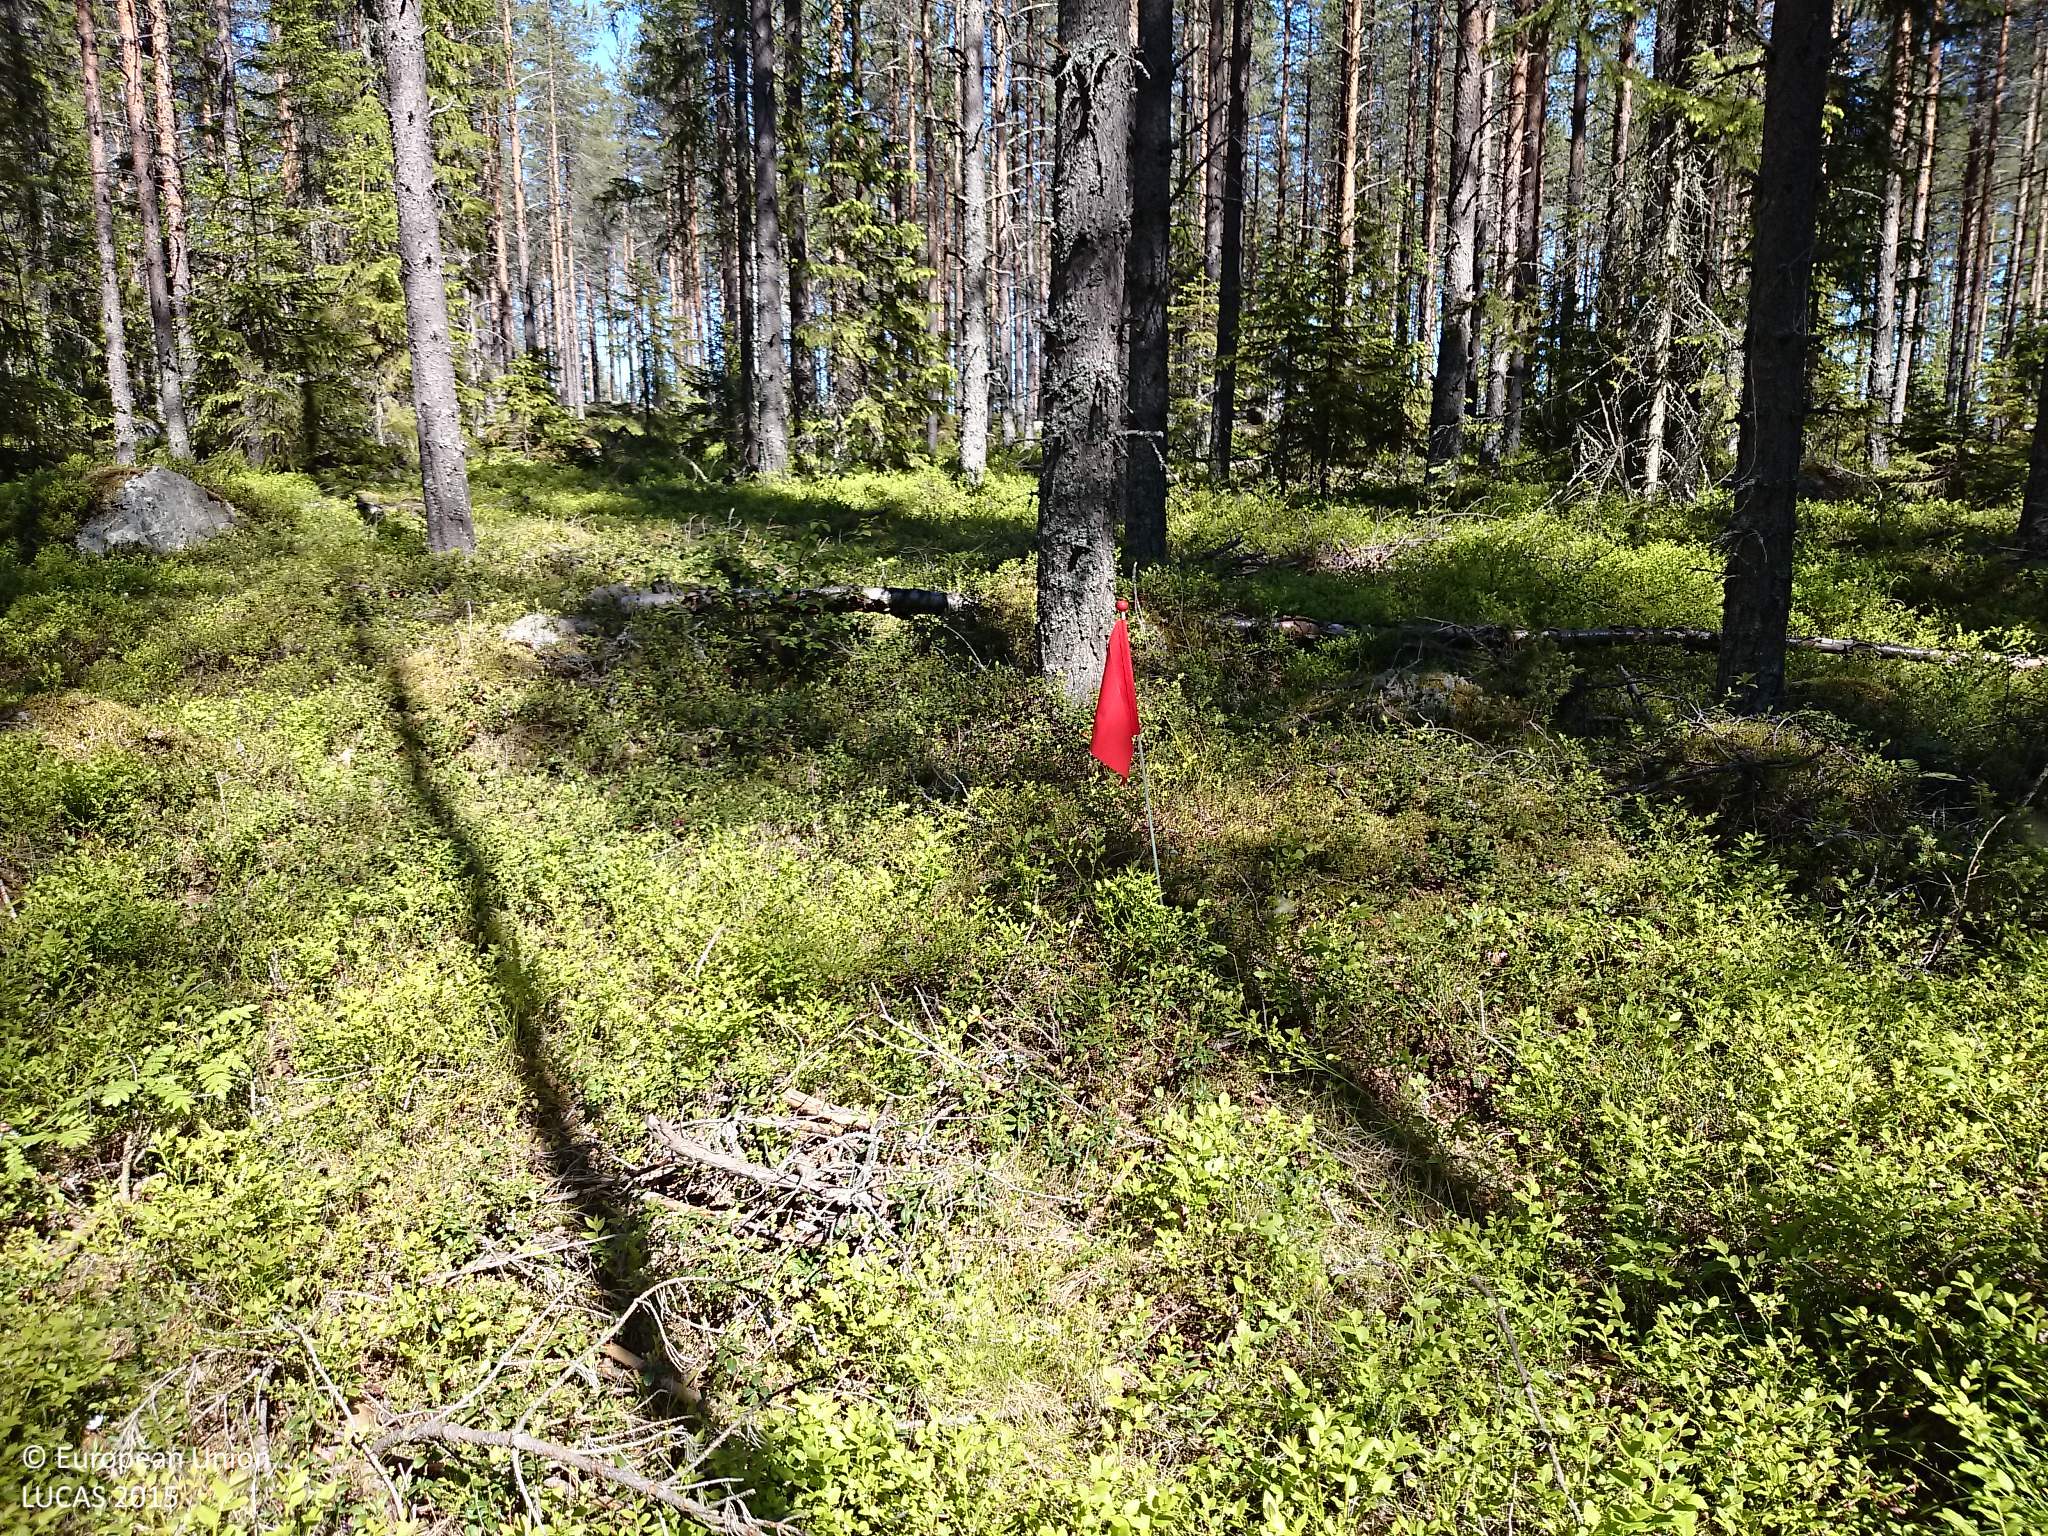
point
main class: Woodland
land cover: Pine dominated coniferous woodland
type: boreal forest
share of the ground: 50 - 75 %
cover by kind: coniferous forest trees 65 %, shrubs 35 %
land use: Forestry
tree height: > 5 m
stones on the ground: > 50 %
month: June
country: SE
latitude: 63.9597
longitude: 20.7436
